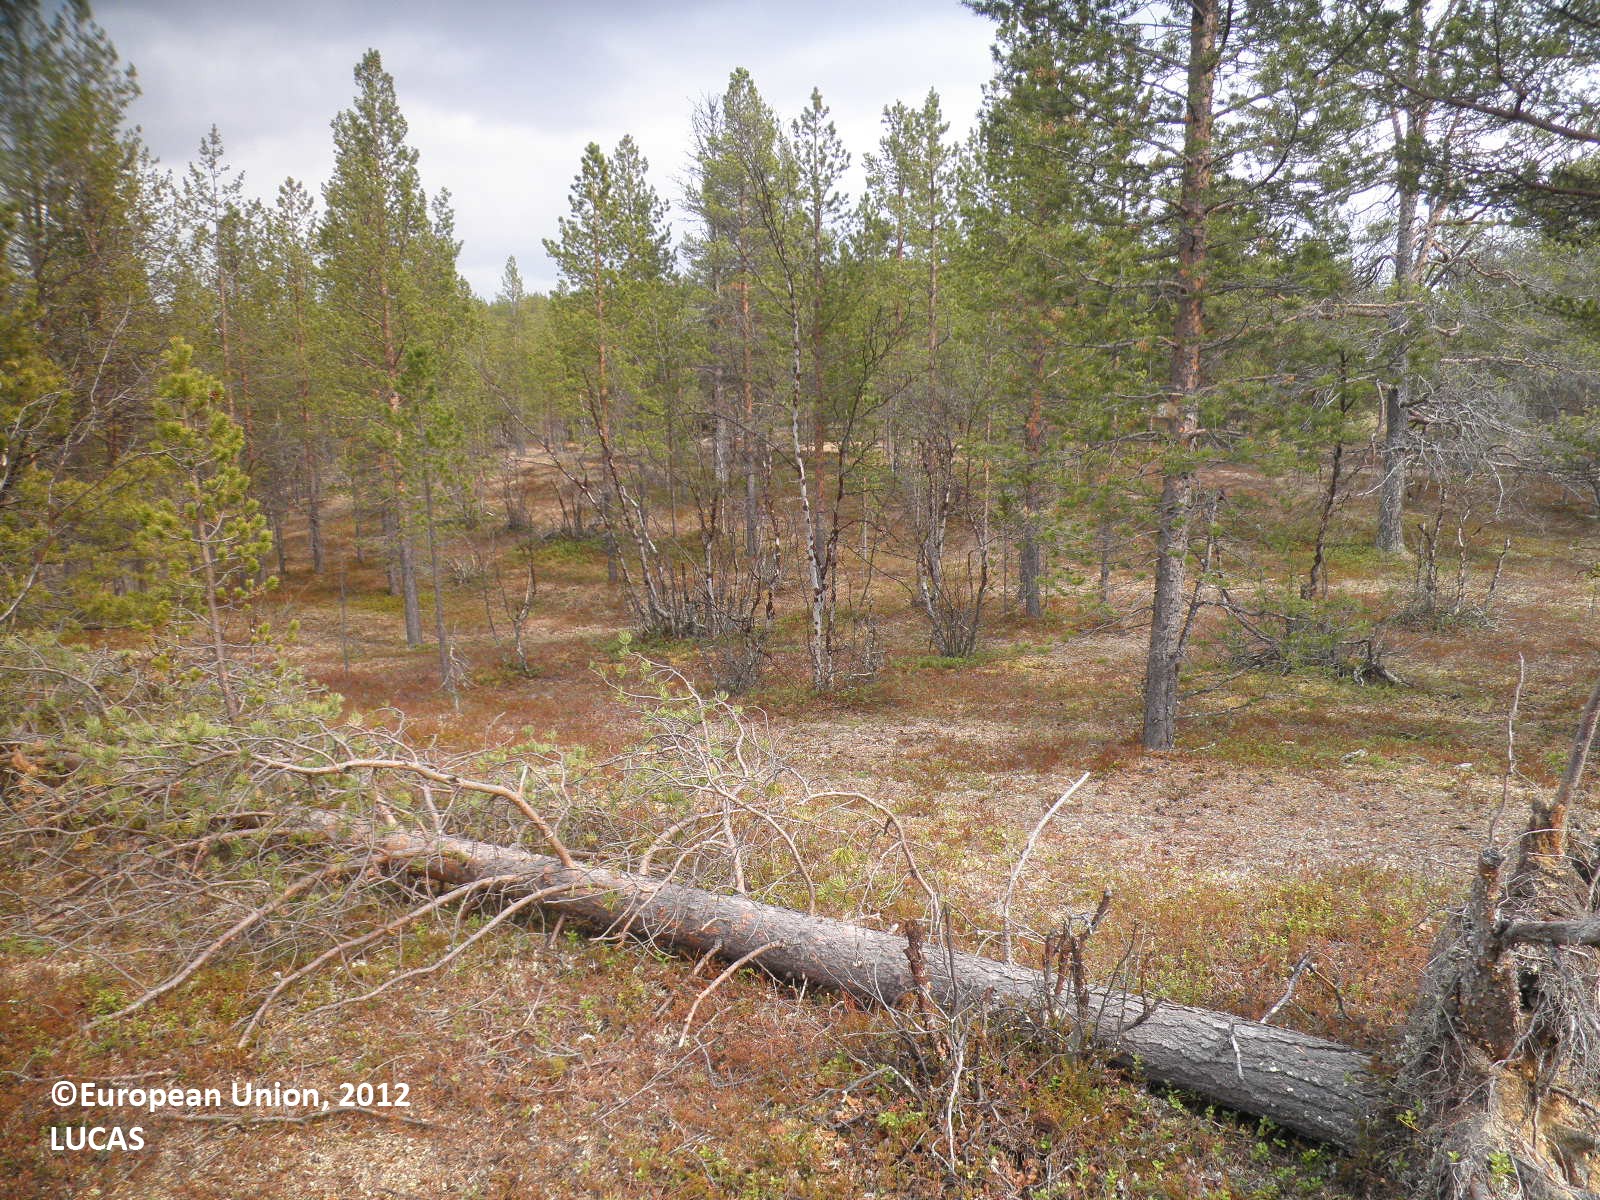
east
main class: Woodland
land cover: Pine dominated mixed woodland
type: boreal forest
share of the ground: > 75 %
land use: Forestry
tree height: > 5 m
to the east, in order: Pine dominated mixed woodland; Pine dominated coniferous woodland; Pine dominated mixed woodland; Tracks; Pine dominated mixed woodland; Paved roads, cycling and walking lanes; Pine dominated mixed woodland
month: May
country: FI
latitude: 69.2476
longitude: 26.8147
